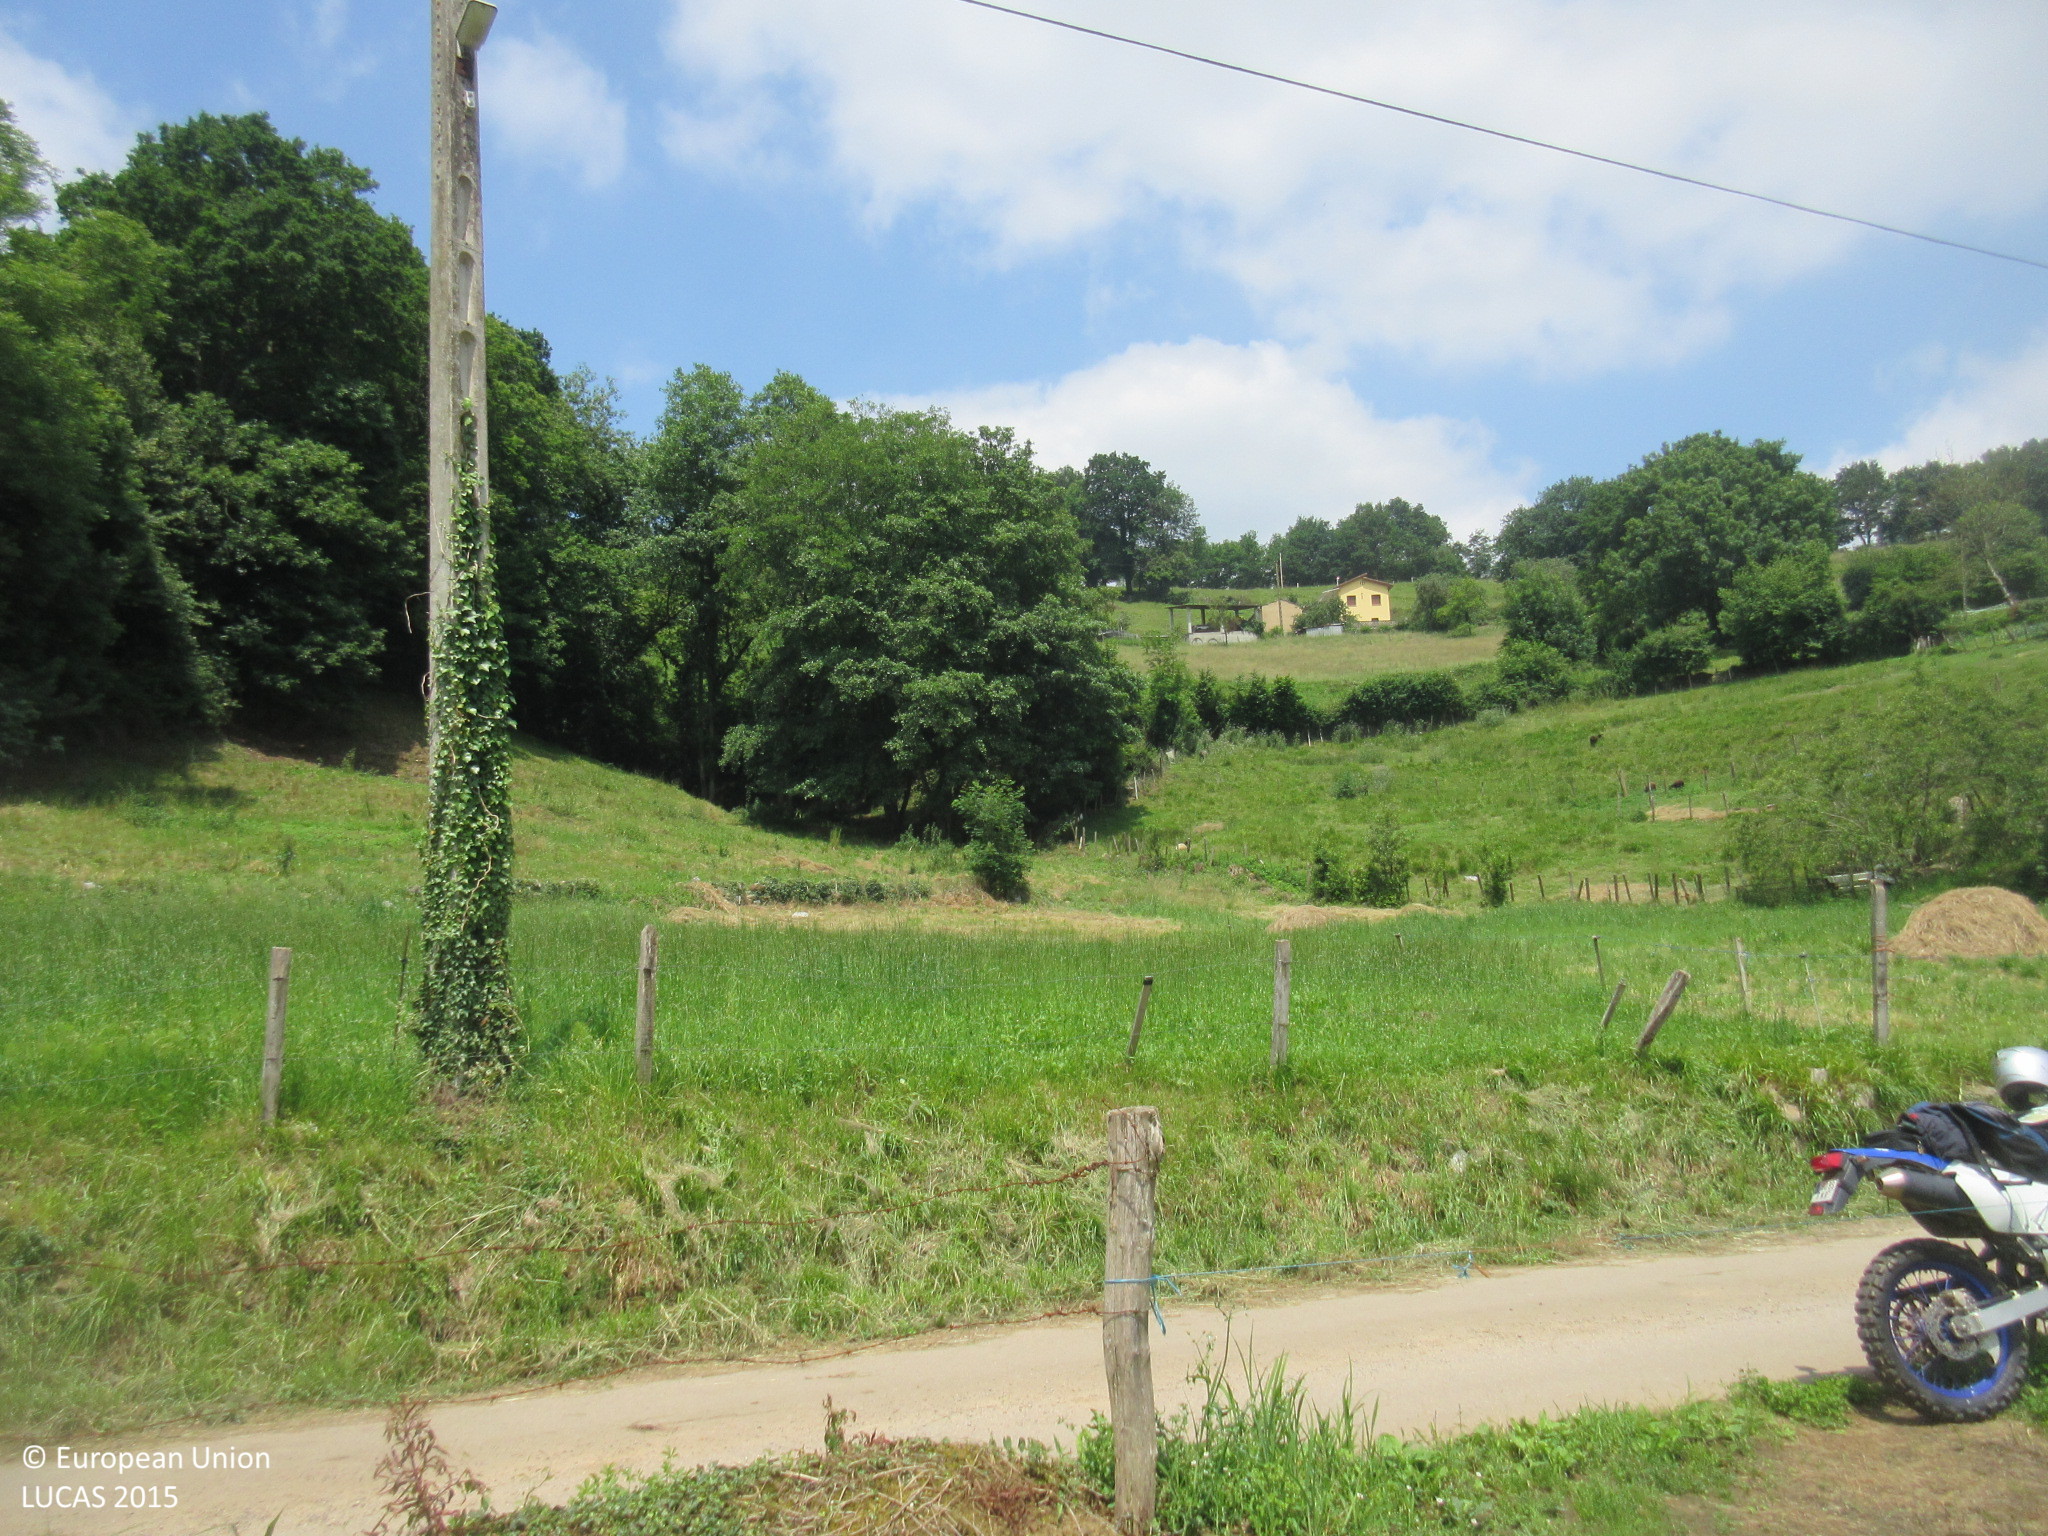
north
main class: Cropland
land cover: Dry pulses
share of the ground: 50 - 75 %
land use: Agriculture (excluding fallow land and kitchen gardens)
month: June
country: ES
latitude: 43.3533
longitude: -6.0194
